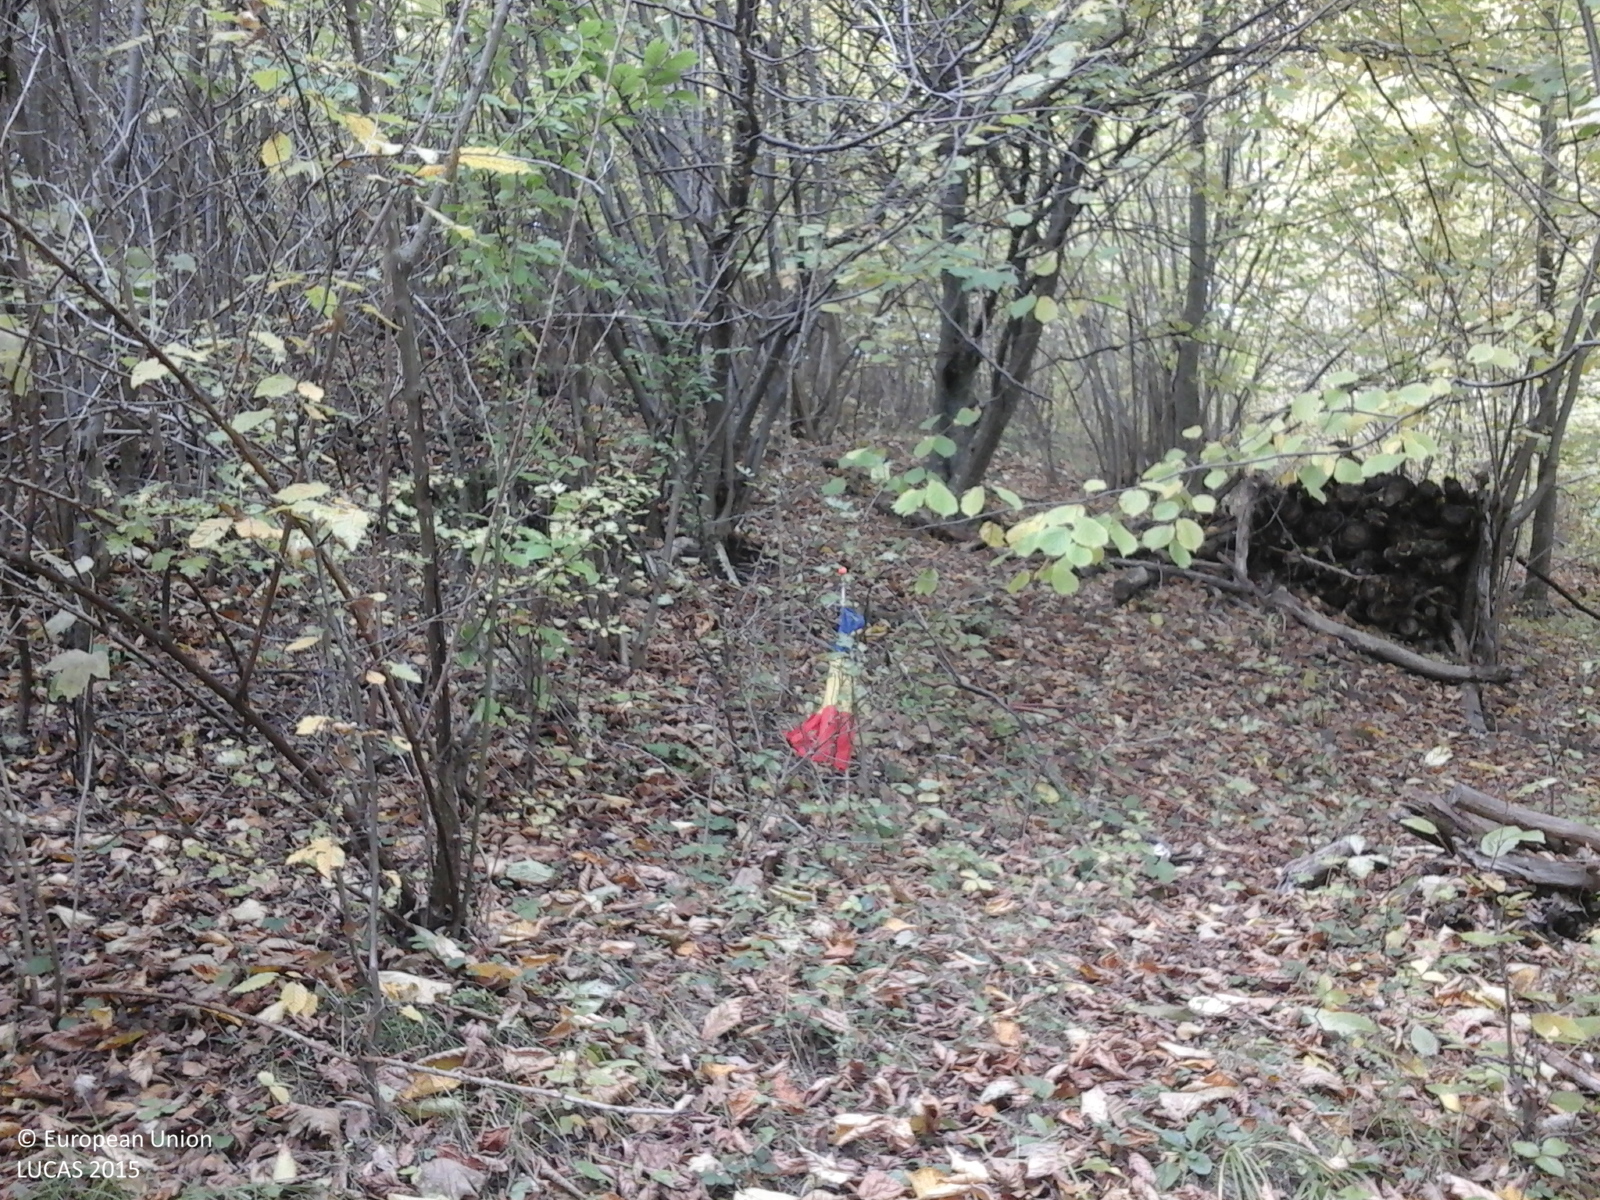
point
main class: Woodland
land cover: Broadleaved woodland
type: beech forest
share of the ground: > 75 %
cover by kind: broadleaved forest trees 100 %
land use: Forestry
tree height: > 5 m
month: October
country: RO
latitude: 46.4546
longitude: 25.4041
